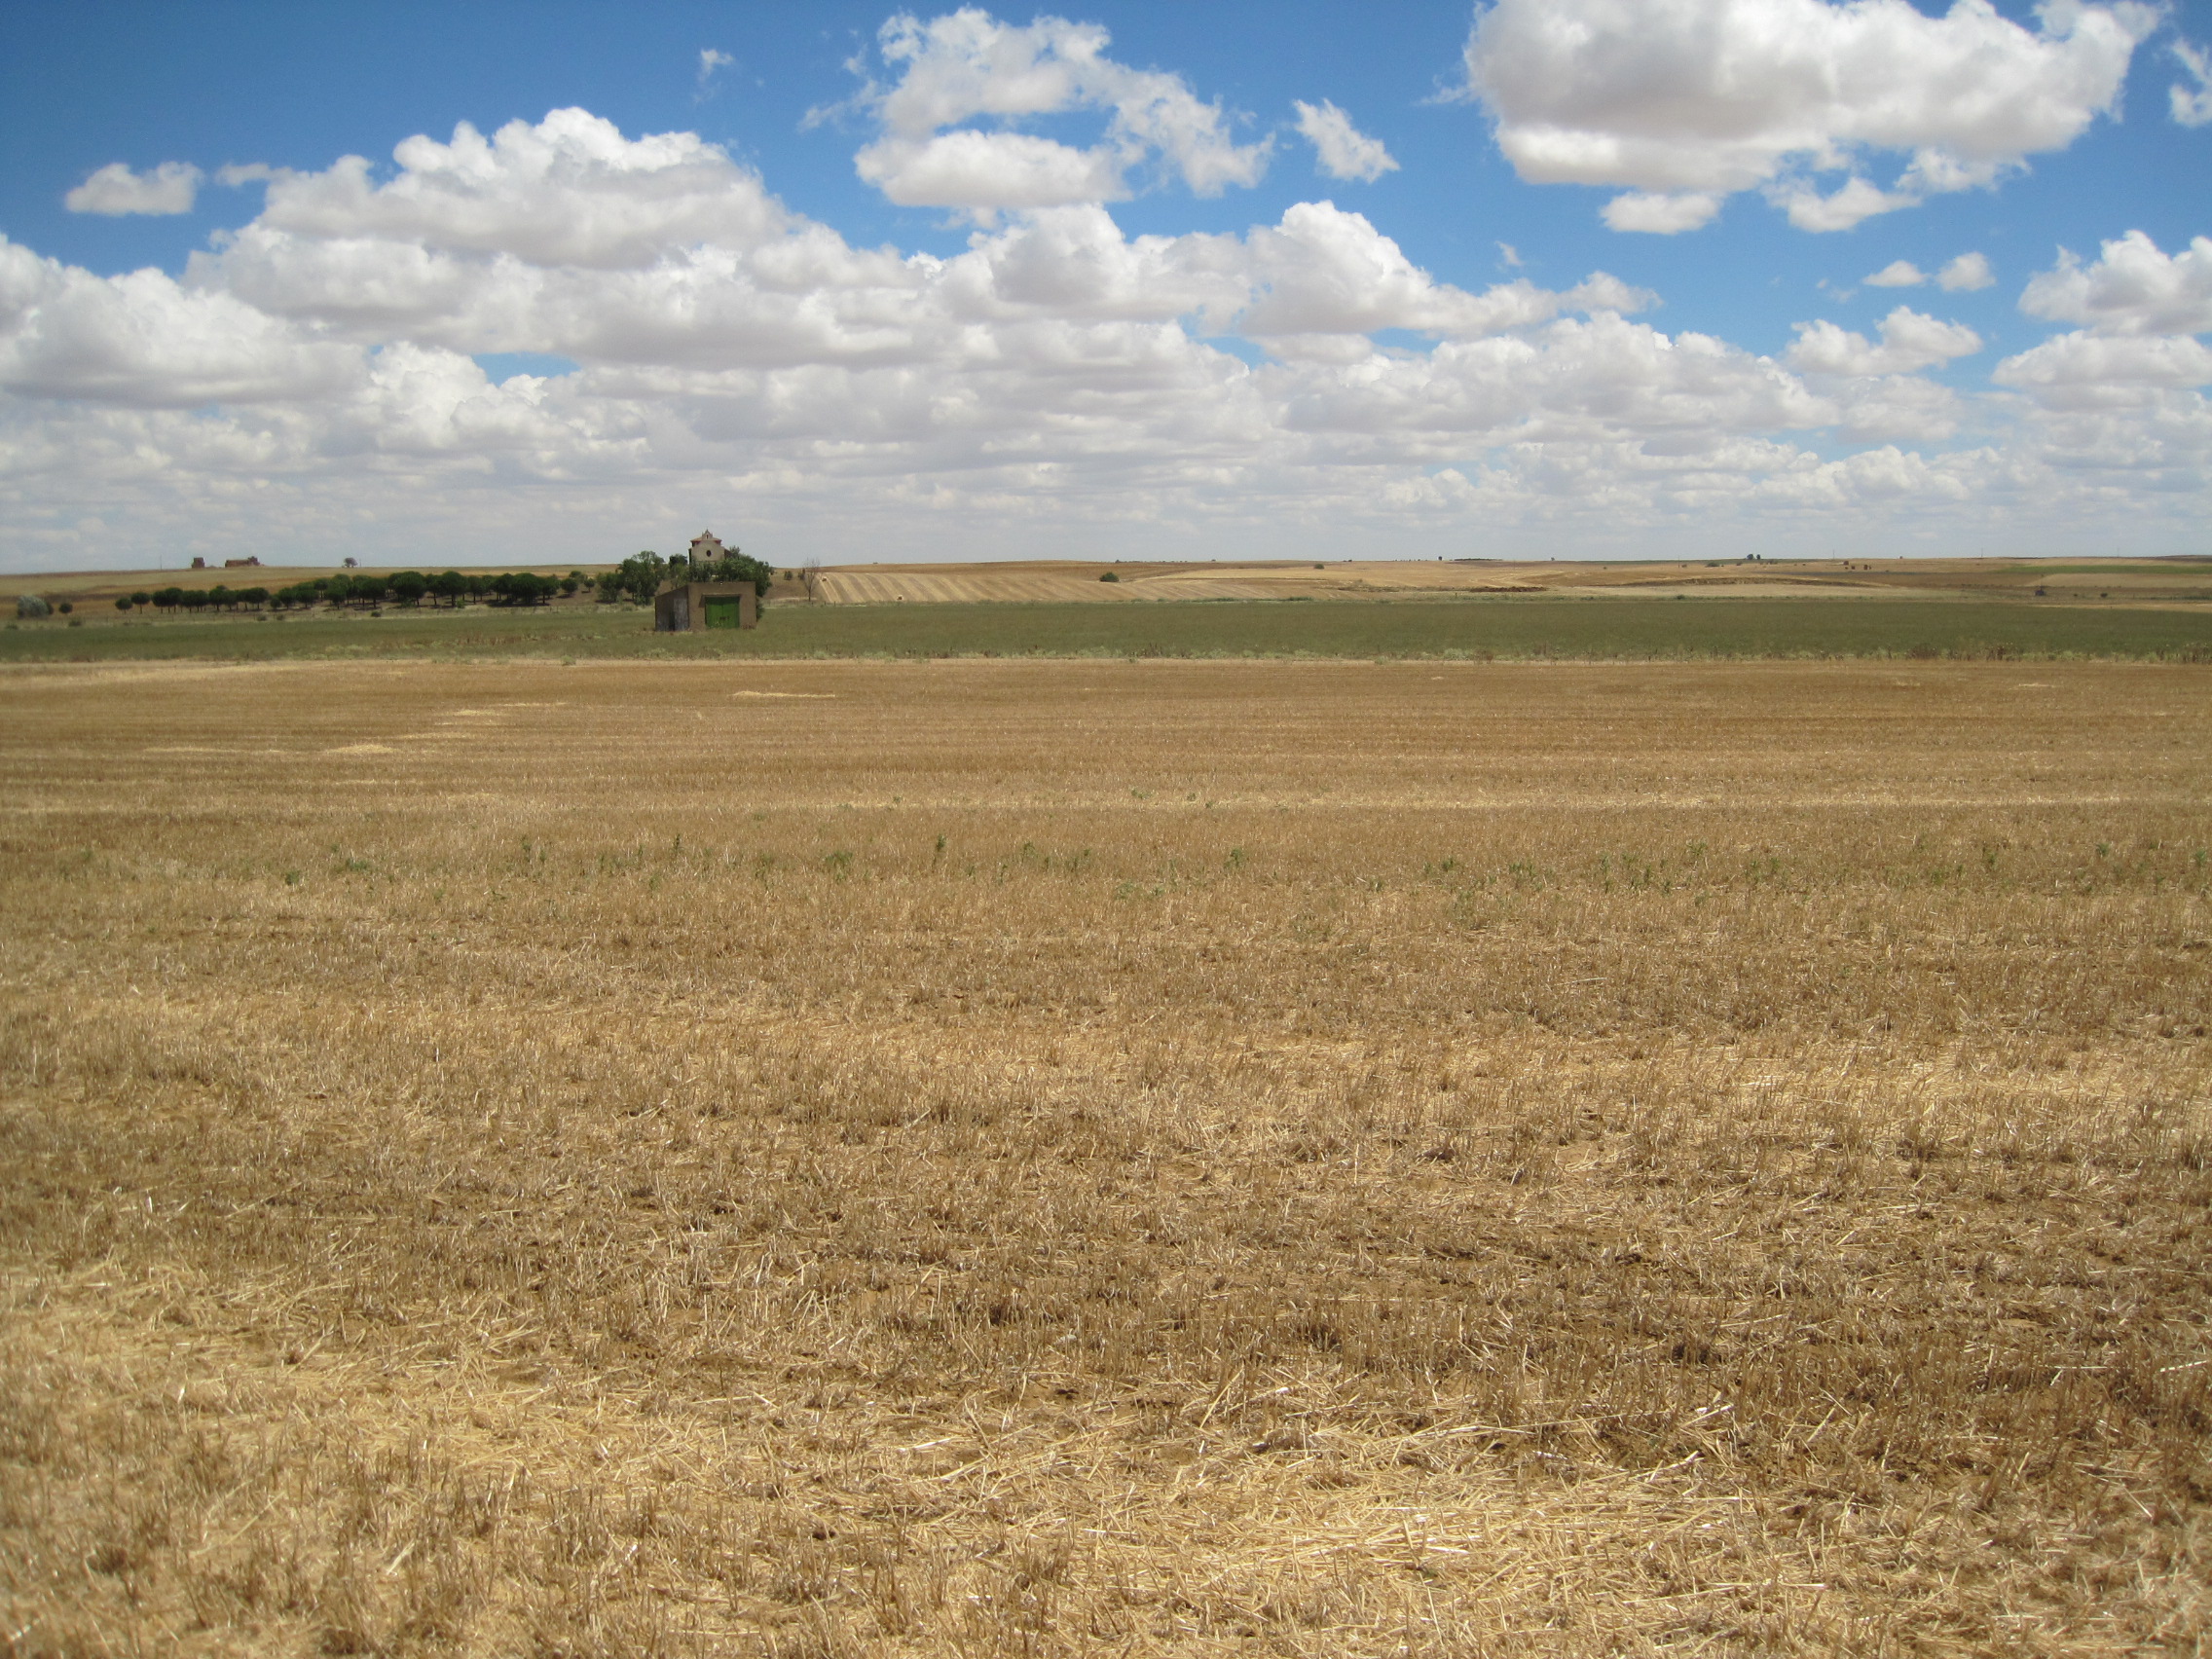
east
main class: Cropland
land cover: Barley
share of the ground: < 10 %
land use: Agriculture (excluding fallow land and kitchen gardens)
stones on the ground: < 10 %
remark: Harvested field
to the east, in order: Barley; Grass margins; Tracks; Grass margins; Lucerne
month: July
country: ES
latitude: 41.9316
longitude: -5.4875
